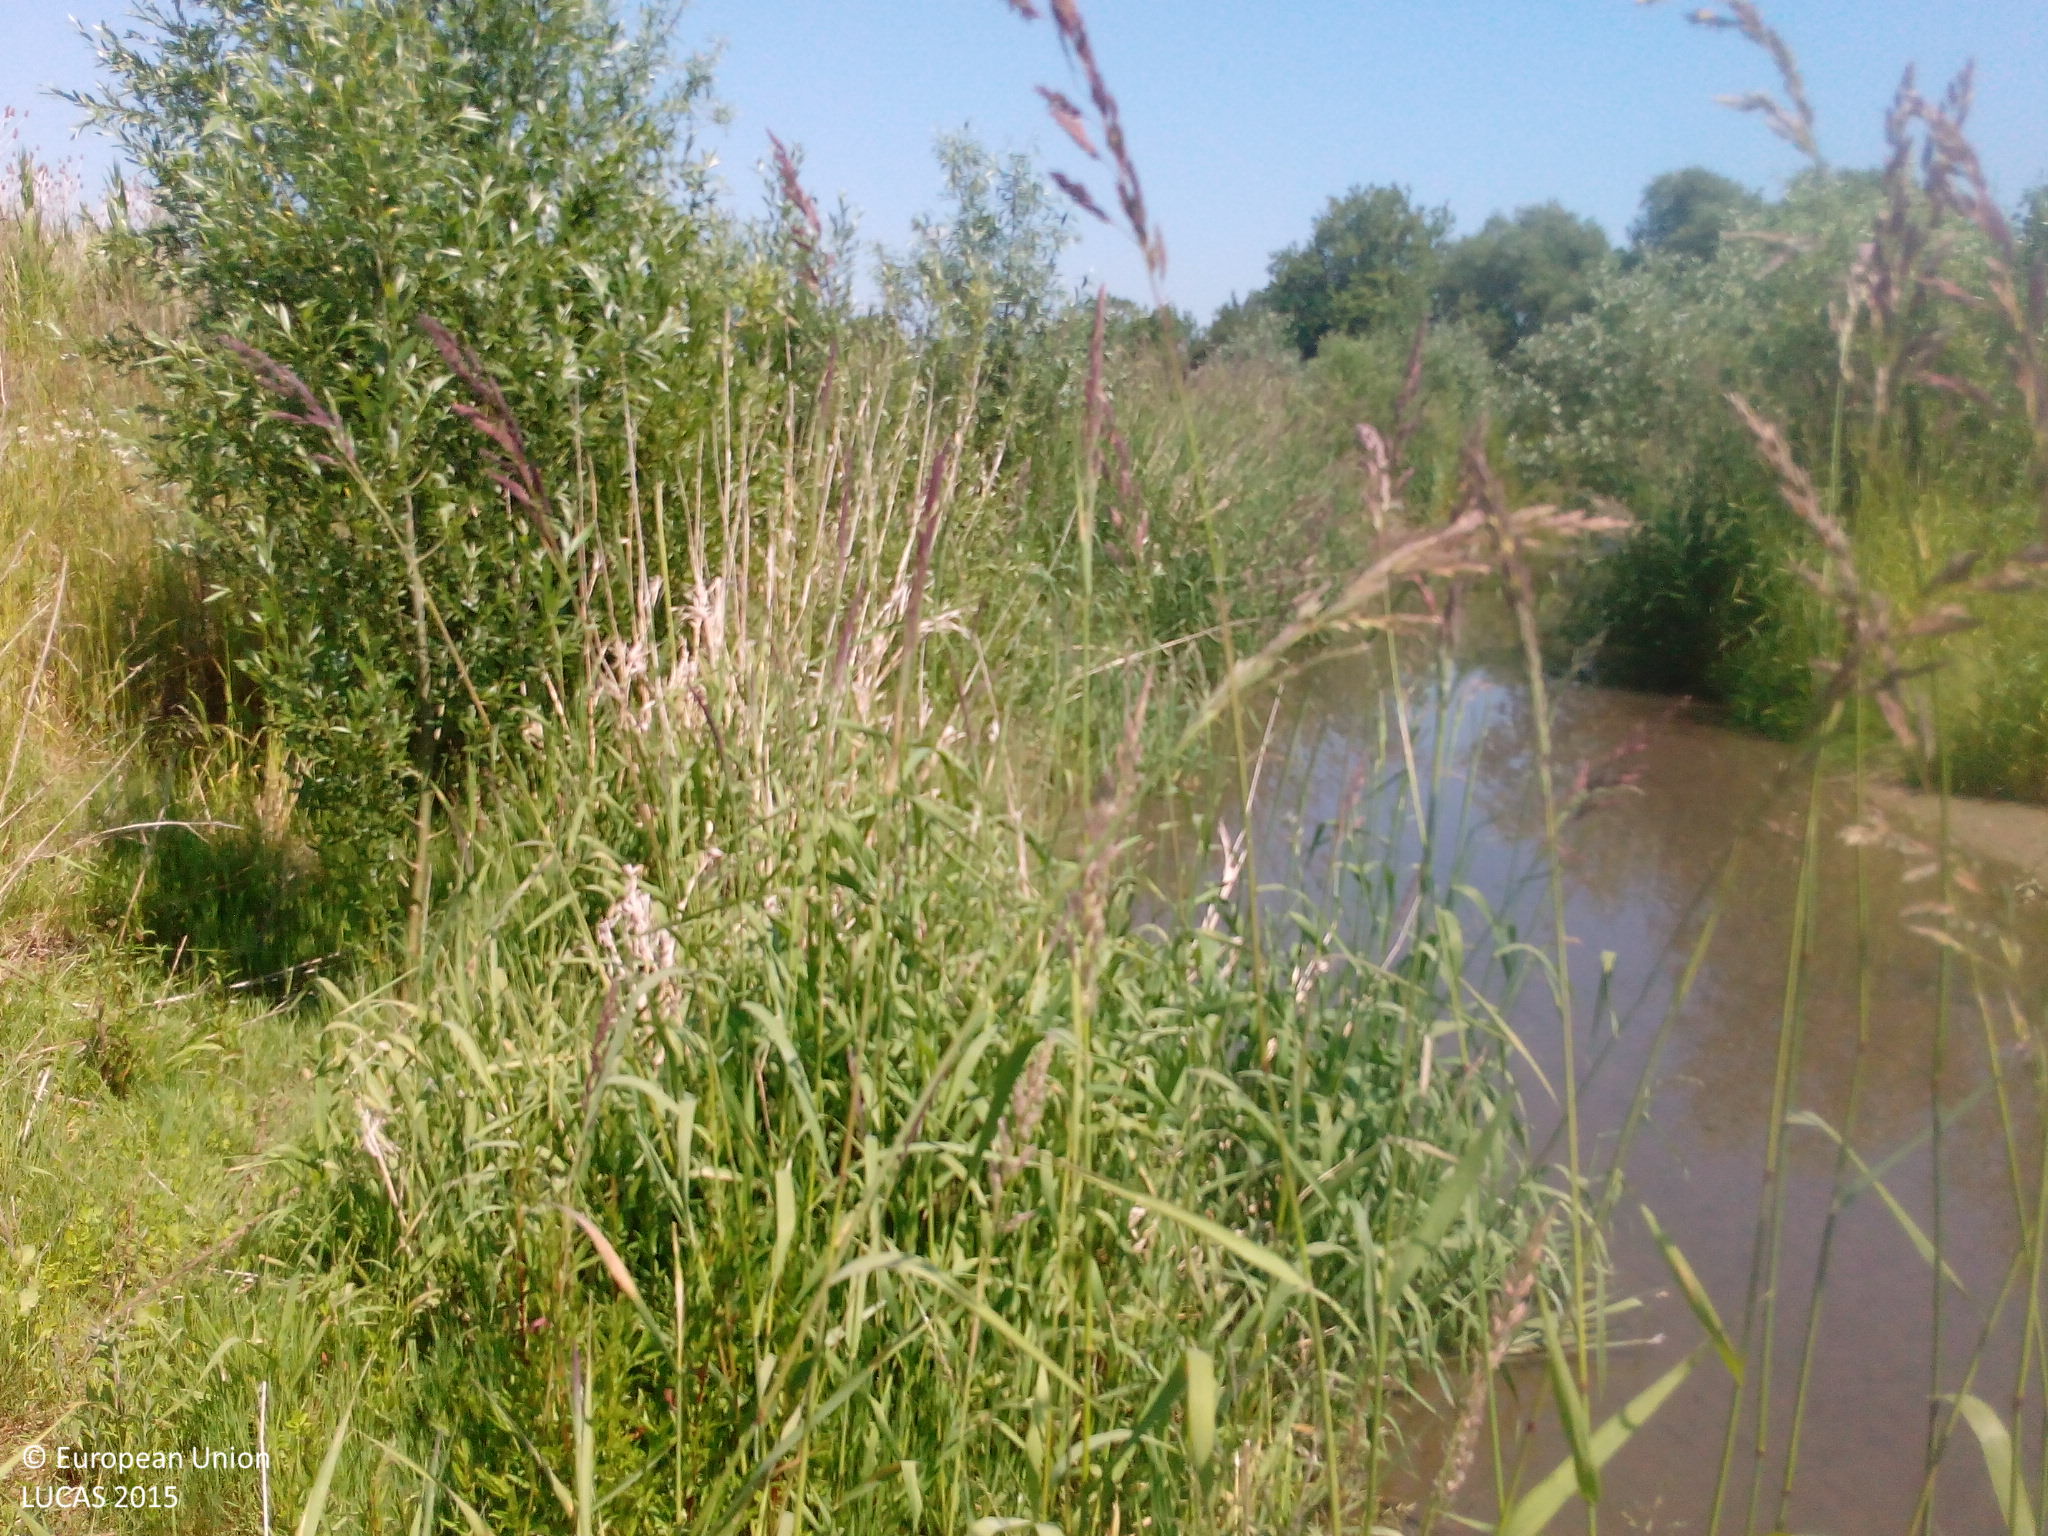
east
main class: Woodland
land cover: Broadleaved woodland
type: floodplain forest
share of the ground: 50 - 75 %
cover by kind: broadleaved forest trees 50 %, herbaceous plants 30 %, shrubs 20 %
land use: Semi-natural and natural areas not in use
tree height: < 5 m
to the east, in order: Broadleaved woodland; Grassland with sparse tree/shrub cover; Inland fresh running water; Grassland without tree/shrub cover; Inland fresh water bodies; Grass margins; Broadleaved woodland; Grass margins; Paved roads, cycling and walking lanes; Rape and turnip rape; Tracks; Grass margins; Electric lines; Common wheat
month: June
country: DE
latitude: 49.7556
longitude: 8.1543
